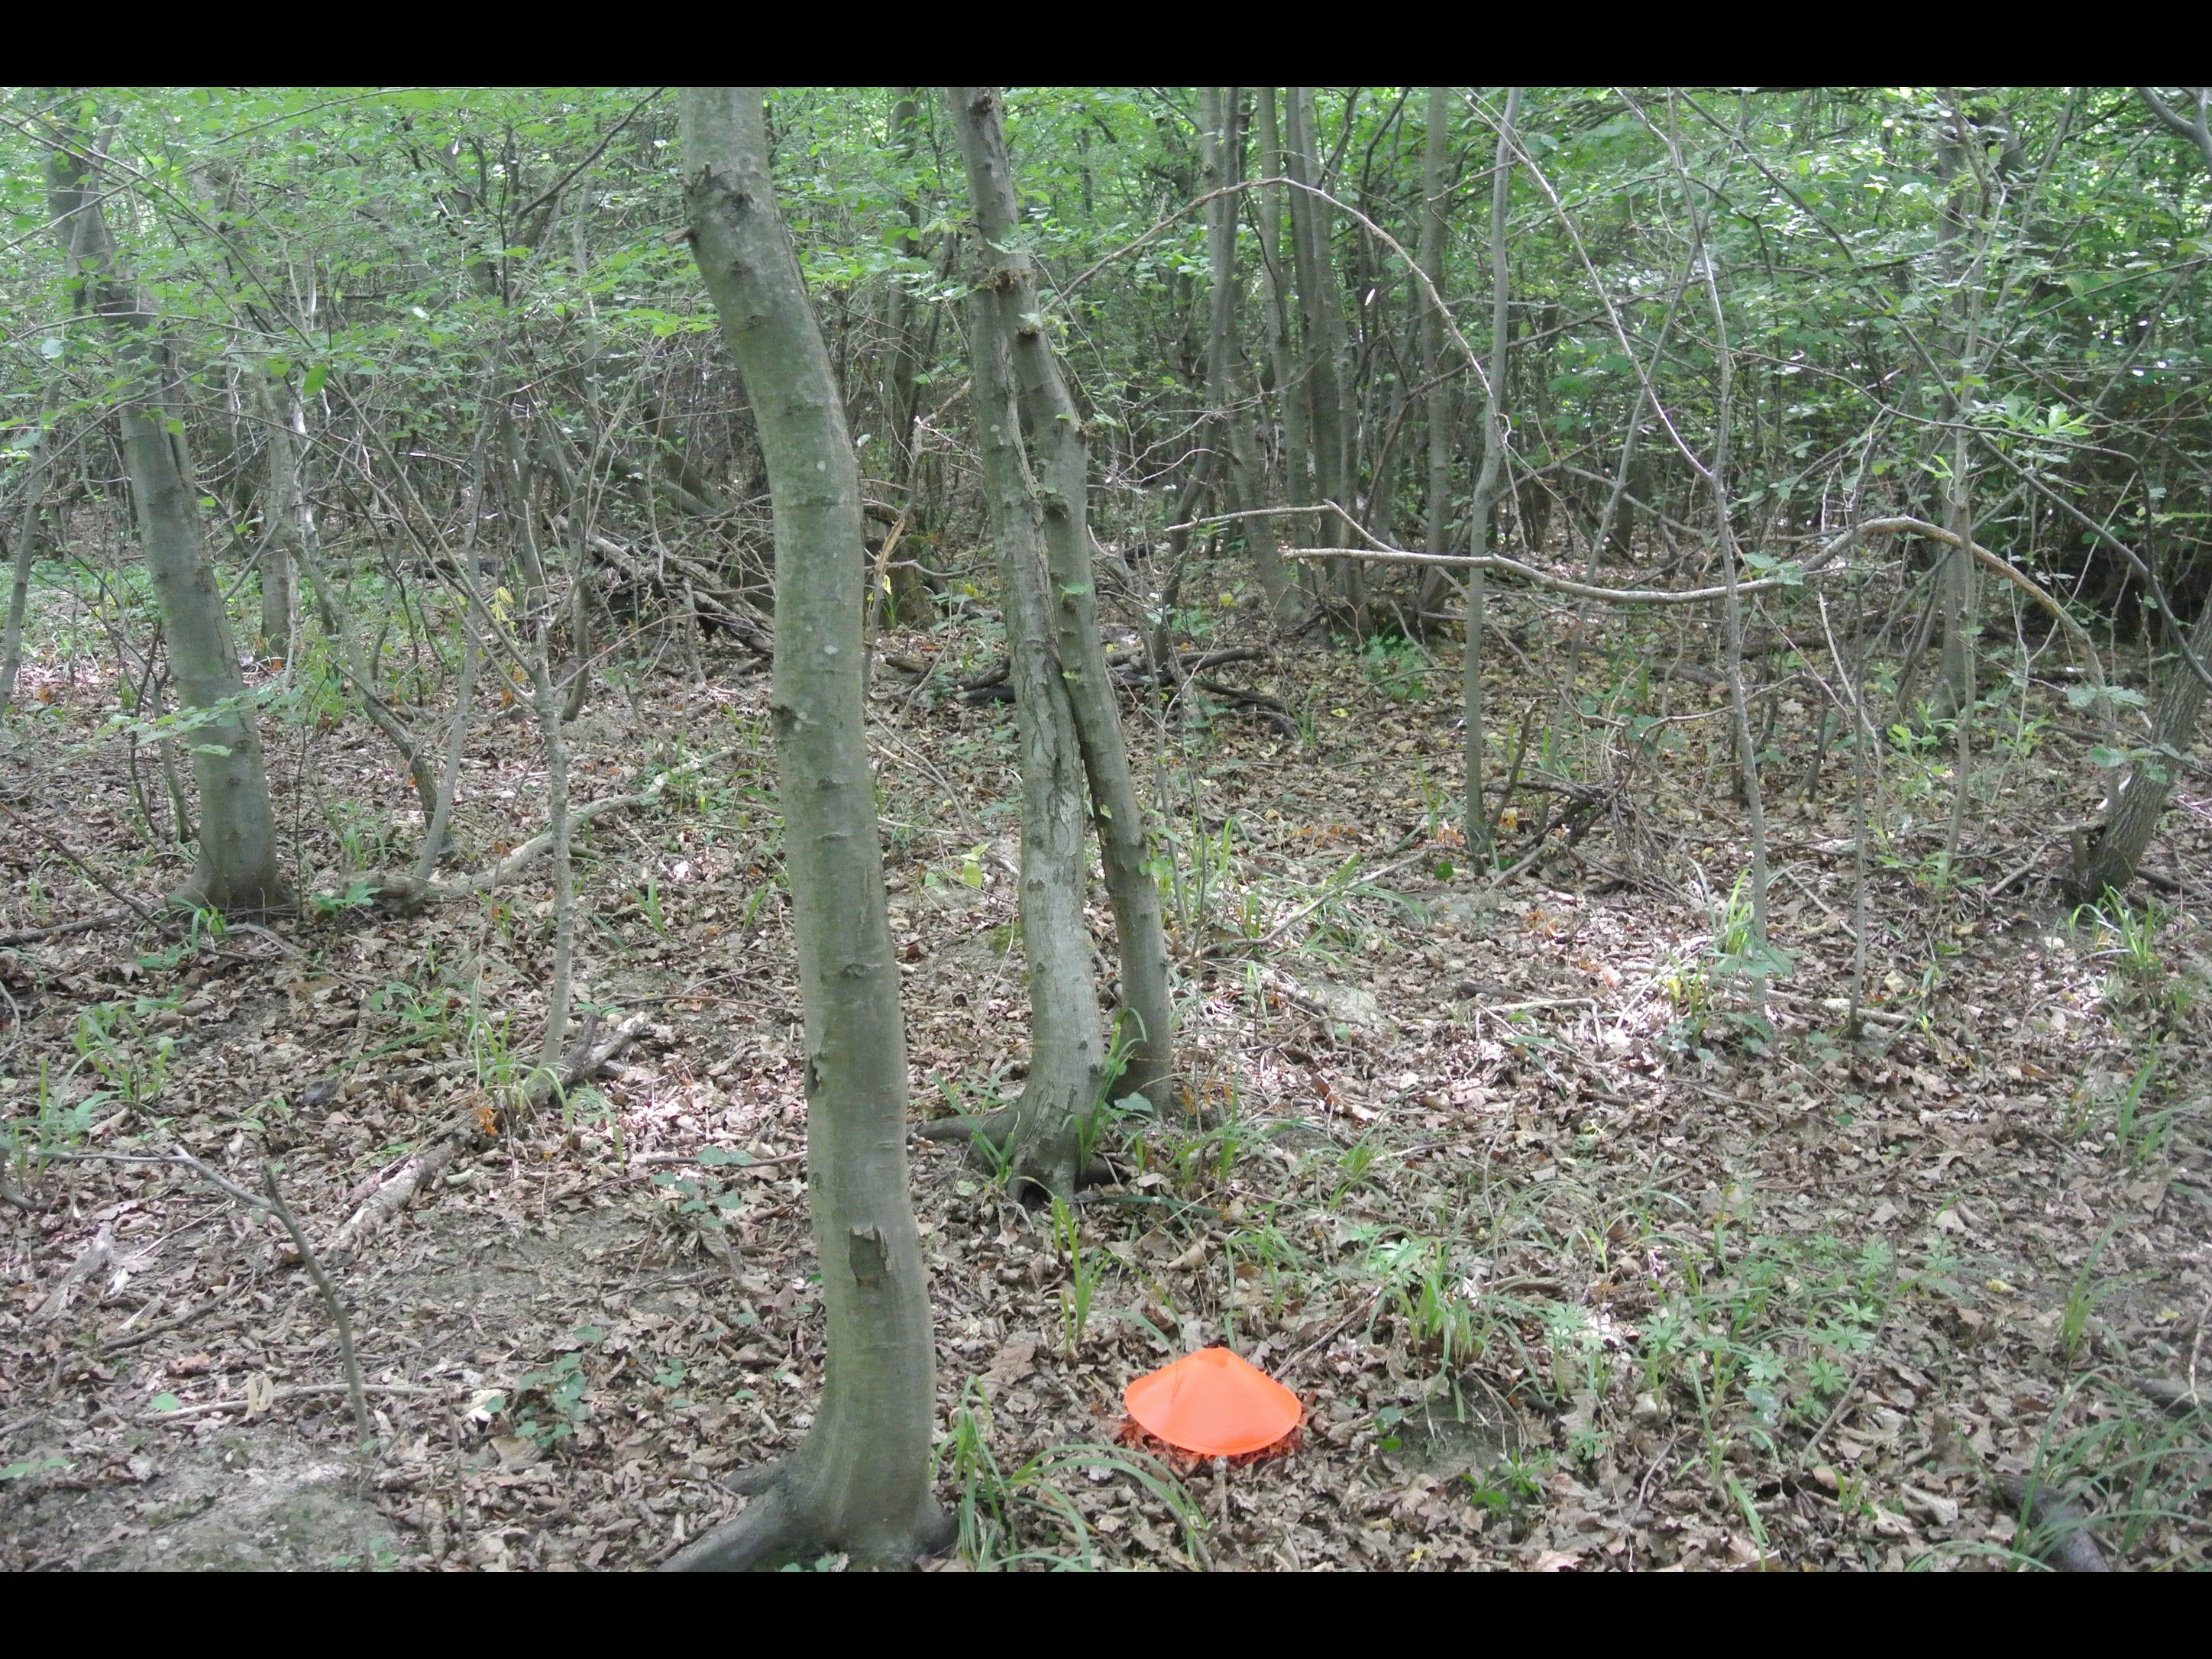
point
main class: Woodland
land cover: Broadleaved woodland
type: beech forest
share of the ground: > 75 %
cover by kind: broadleaved forest trees 90 %, consolidated bare surface 5 %, unconsolidated bare surface 5 %
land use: Forestry
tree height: > 5 m
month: June
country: AT
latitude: 47.9156
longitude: 16.6288
